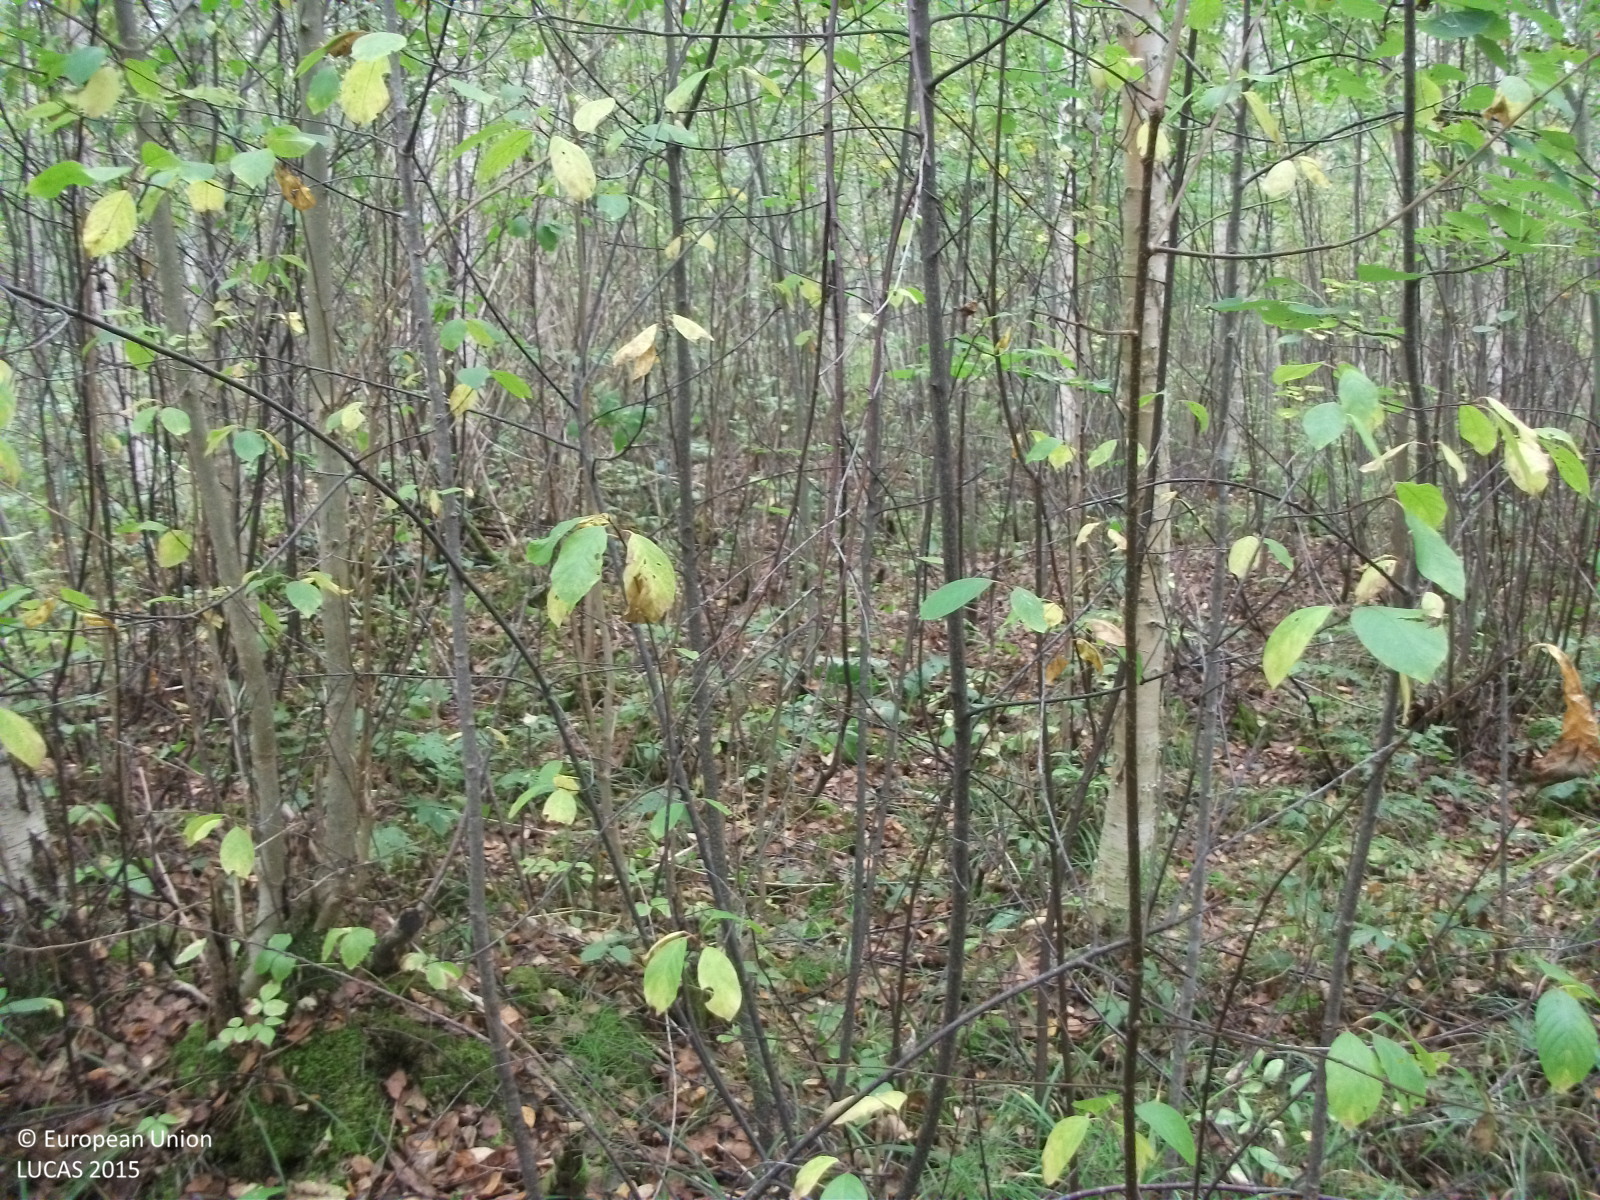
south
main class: Woodland
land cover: Broadleaved woodland
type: non-riverine alder, birch or aspen forest
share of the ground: > 75 %
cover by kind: broadleaved forest trees 90 %, shrubs 5 %, herbaceous plants 5 %
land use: Forestry
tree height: > 5 m
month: September
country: LV
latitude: 57.8074
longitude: 24.3743
